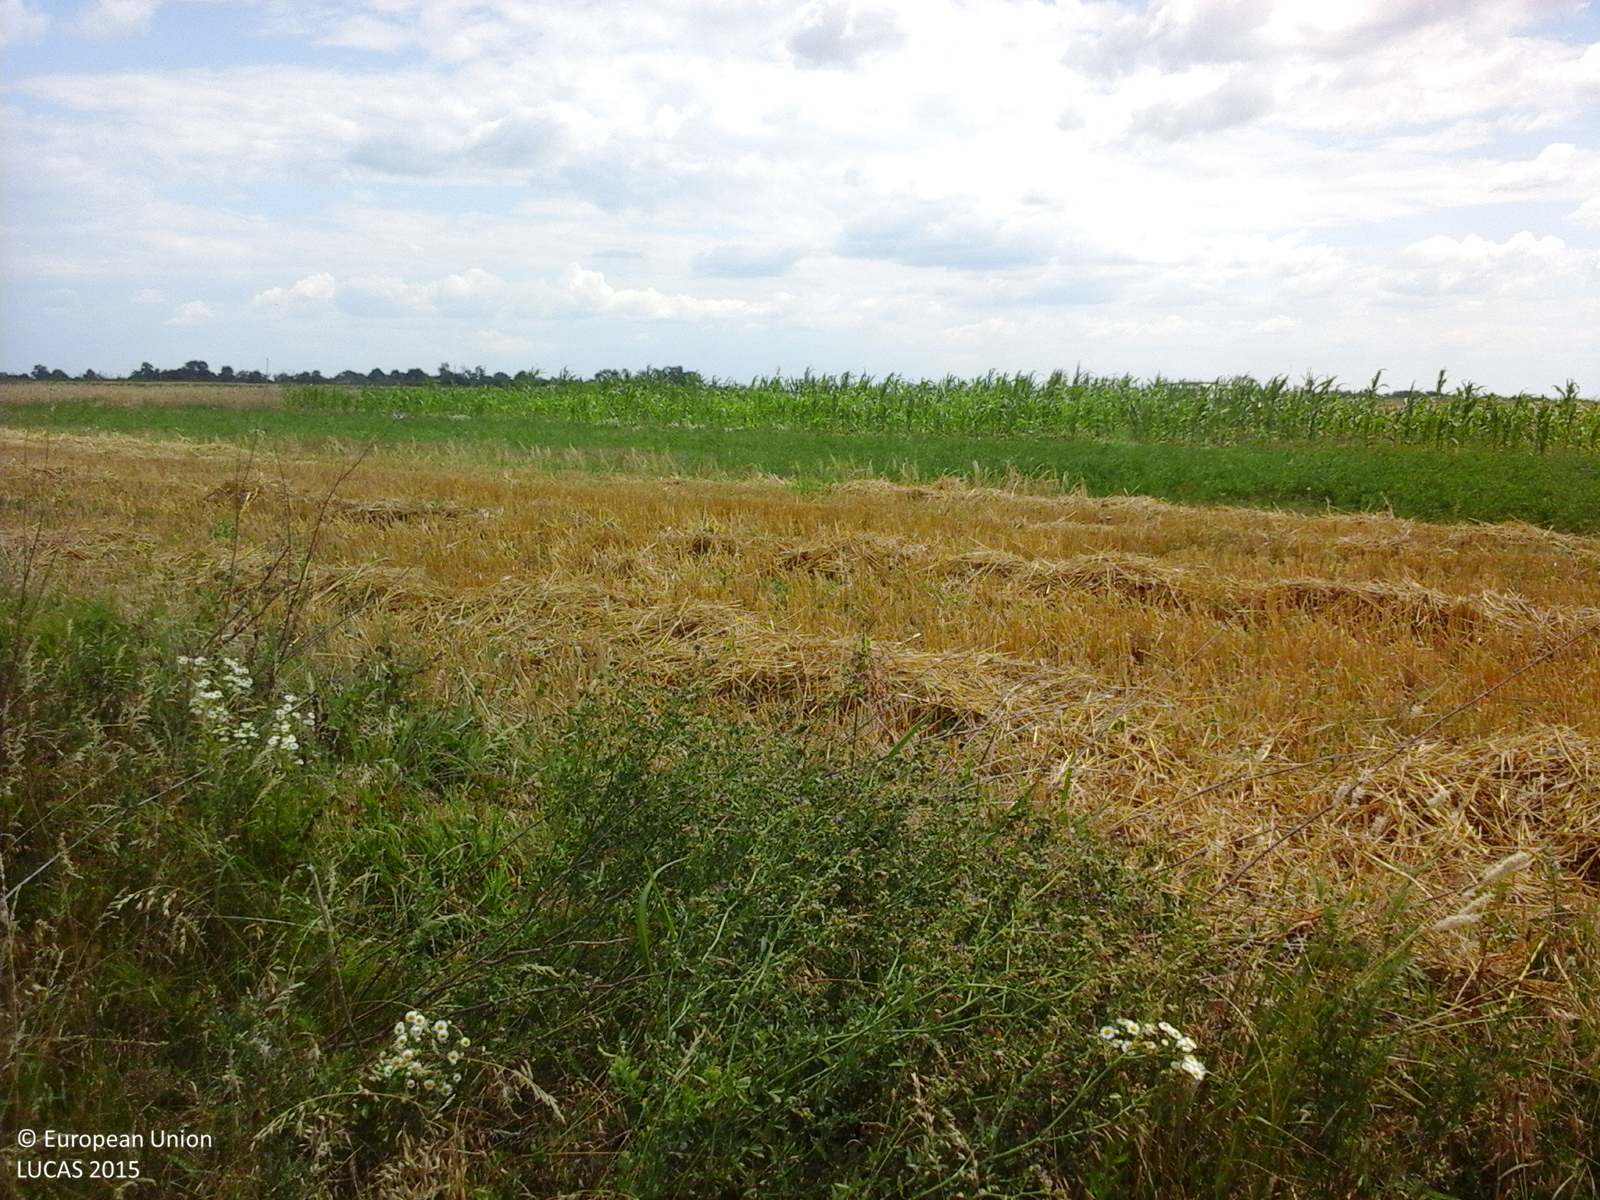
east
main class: Grassland
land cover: Spontaneously vegetated surfaces
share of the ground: > 75 %
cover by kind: herbaceous plants 100 %
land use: Fallow land
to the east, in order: Spontaneously vegetated surfaces; Common wheat; Lucerne; Grass margins; Maize; Grass margins; Tracks; Grass margins; Common wheat; Lucerne; Spontaneously vegetated surfaces
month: July
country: RO
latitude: 44.2906
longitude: 25.4148
